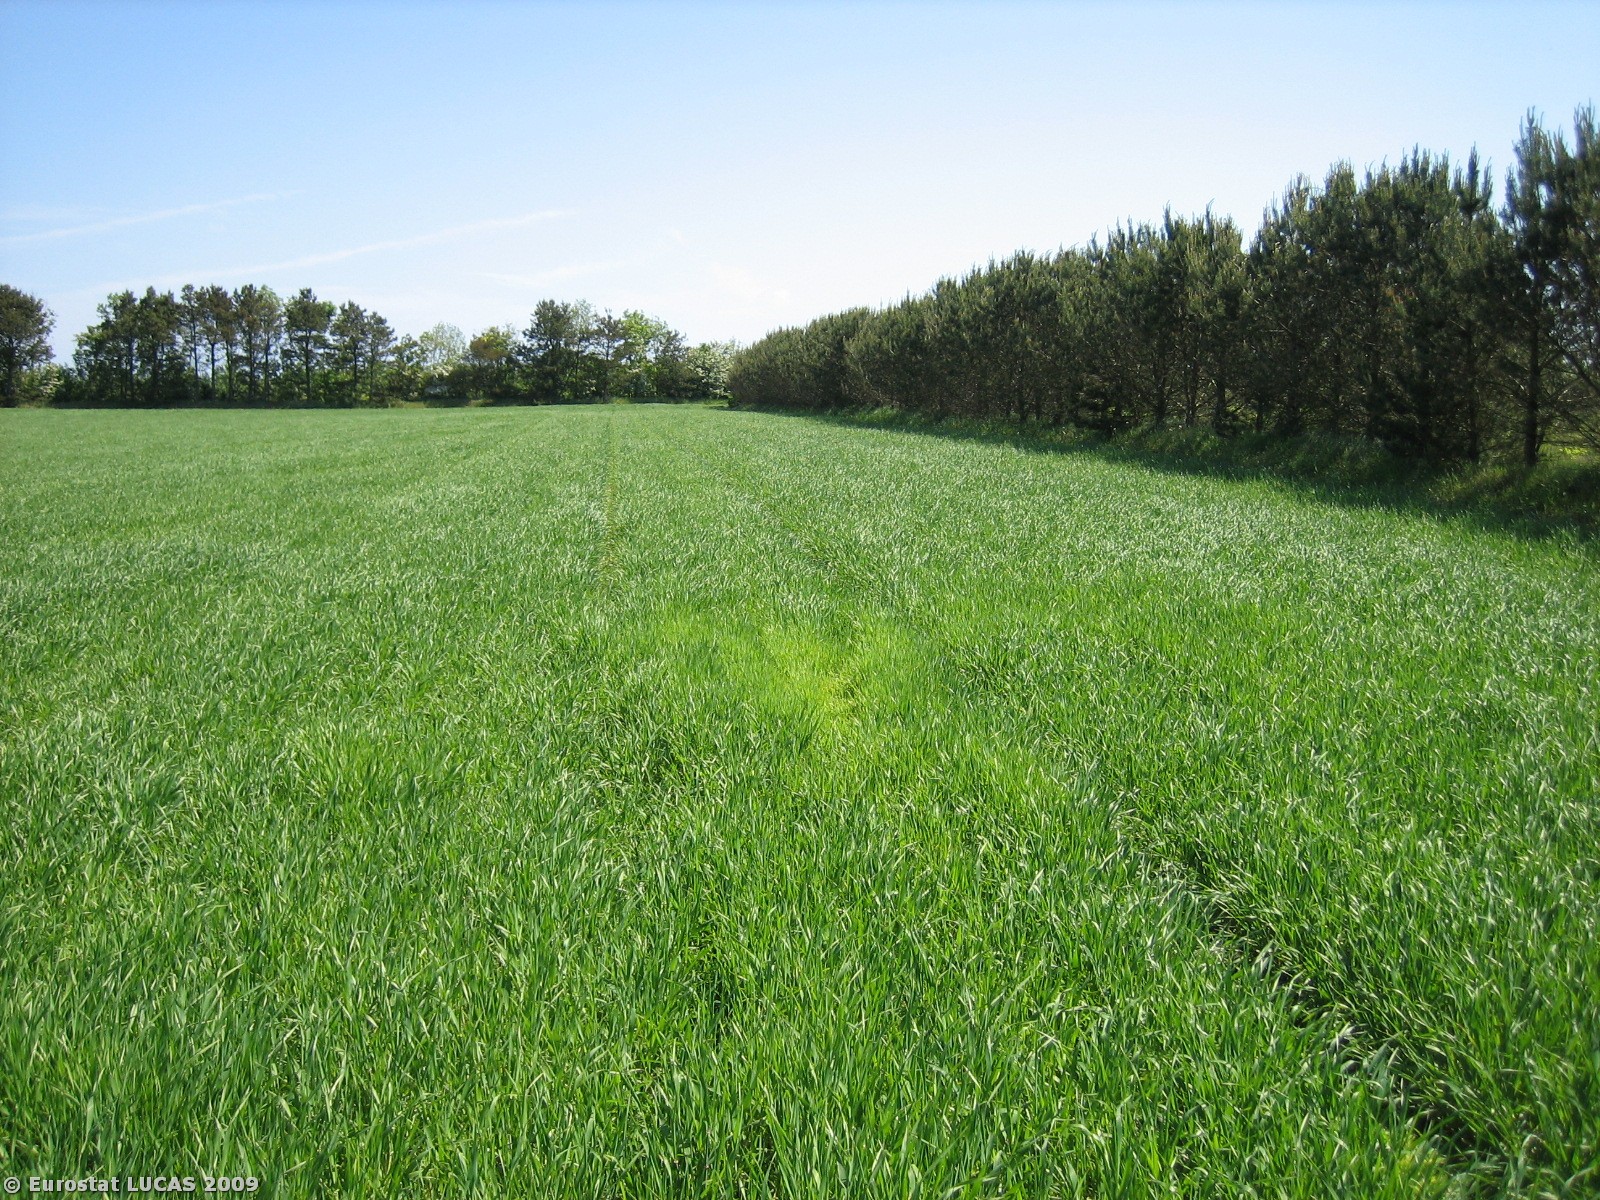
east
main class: Cropland
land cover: Barley
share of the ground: > 75 %
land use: Agriculture (excluding fallow land and kitchen gardens)
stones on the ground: < 10 %
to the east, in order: Barley; Grass margins; Tracks; Coniferous woodland; Broadleaved woodland; Grassland without tree/shrub cover; Grassland with sparse tree/shrub cover; Tracks; Grassland without tree/shrub cover; Grassland with sparse tree/shrub cover; Grassland without tree/shrub cover
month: May
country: DK
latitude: 55.9305
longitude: 8.8008
